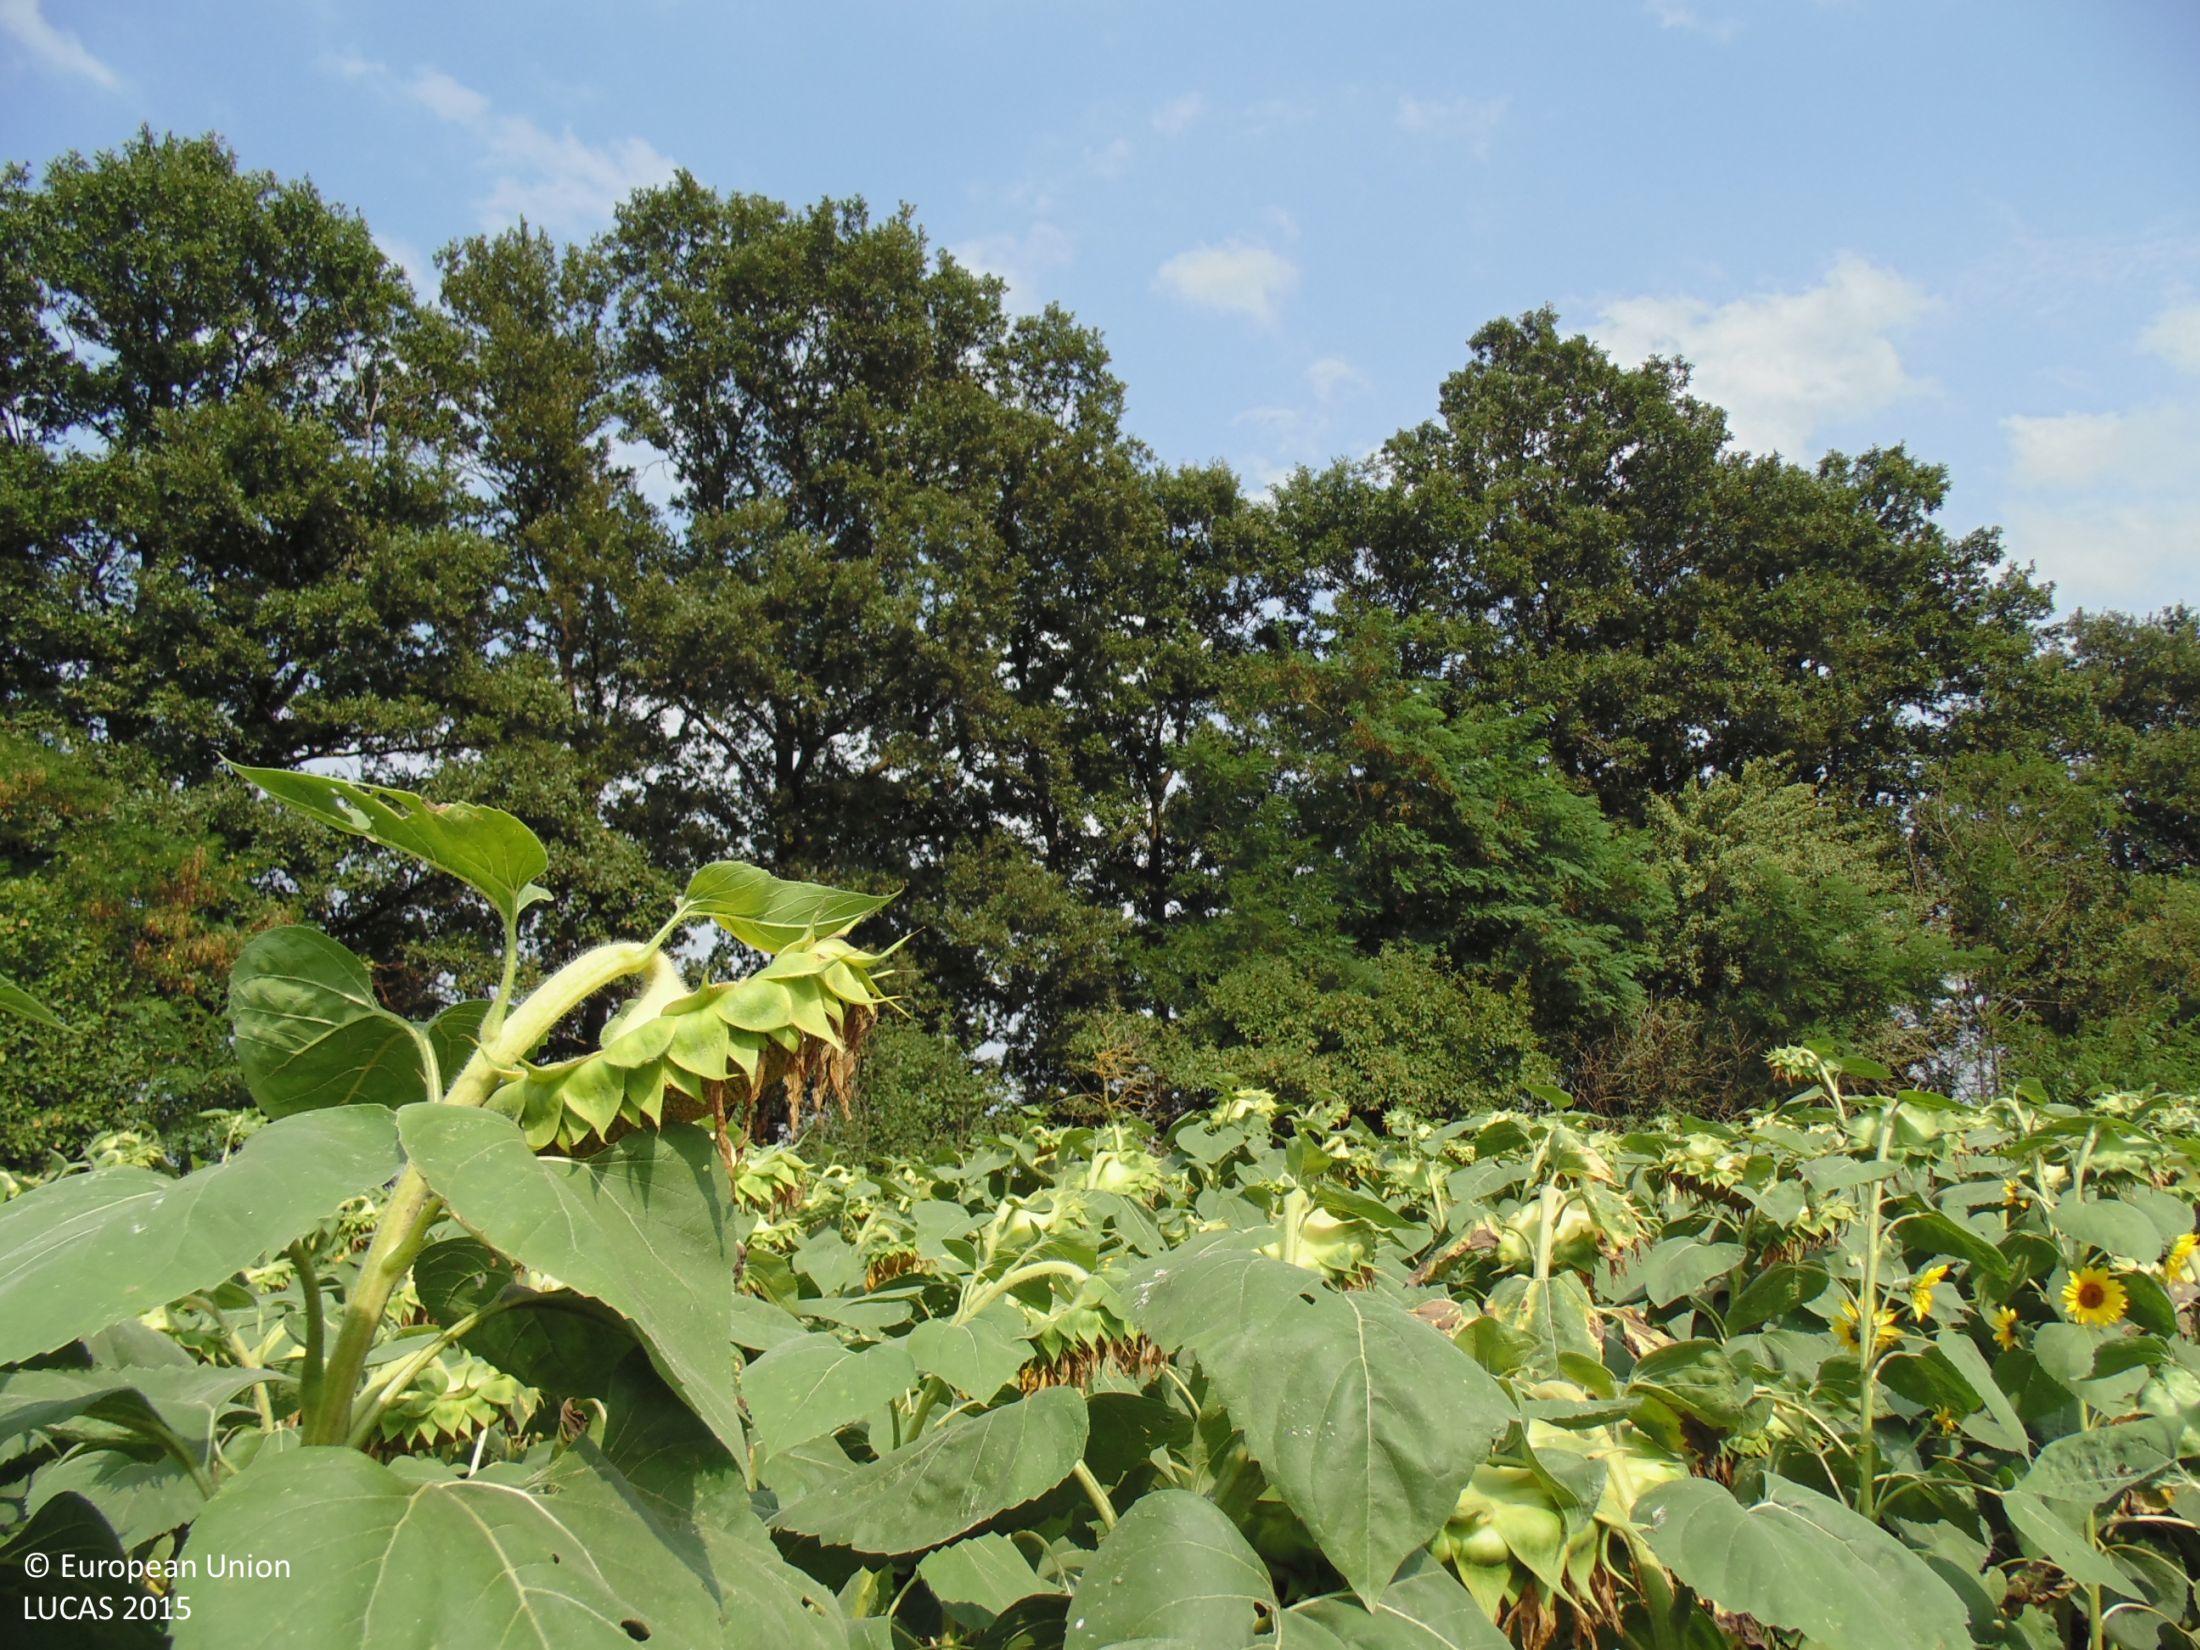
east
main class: Cropland
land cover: Sunflower
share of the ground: > 75 %
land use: Agriculture (excluding fallow land and kitchen gardens)
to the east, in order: Sunflower; Grass margins; Broadleaved woodland; Grass margins; Common wheat; Sunflower
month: July
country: BG
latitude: 43.6046
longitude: 28.0248
